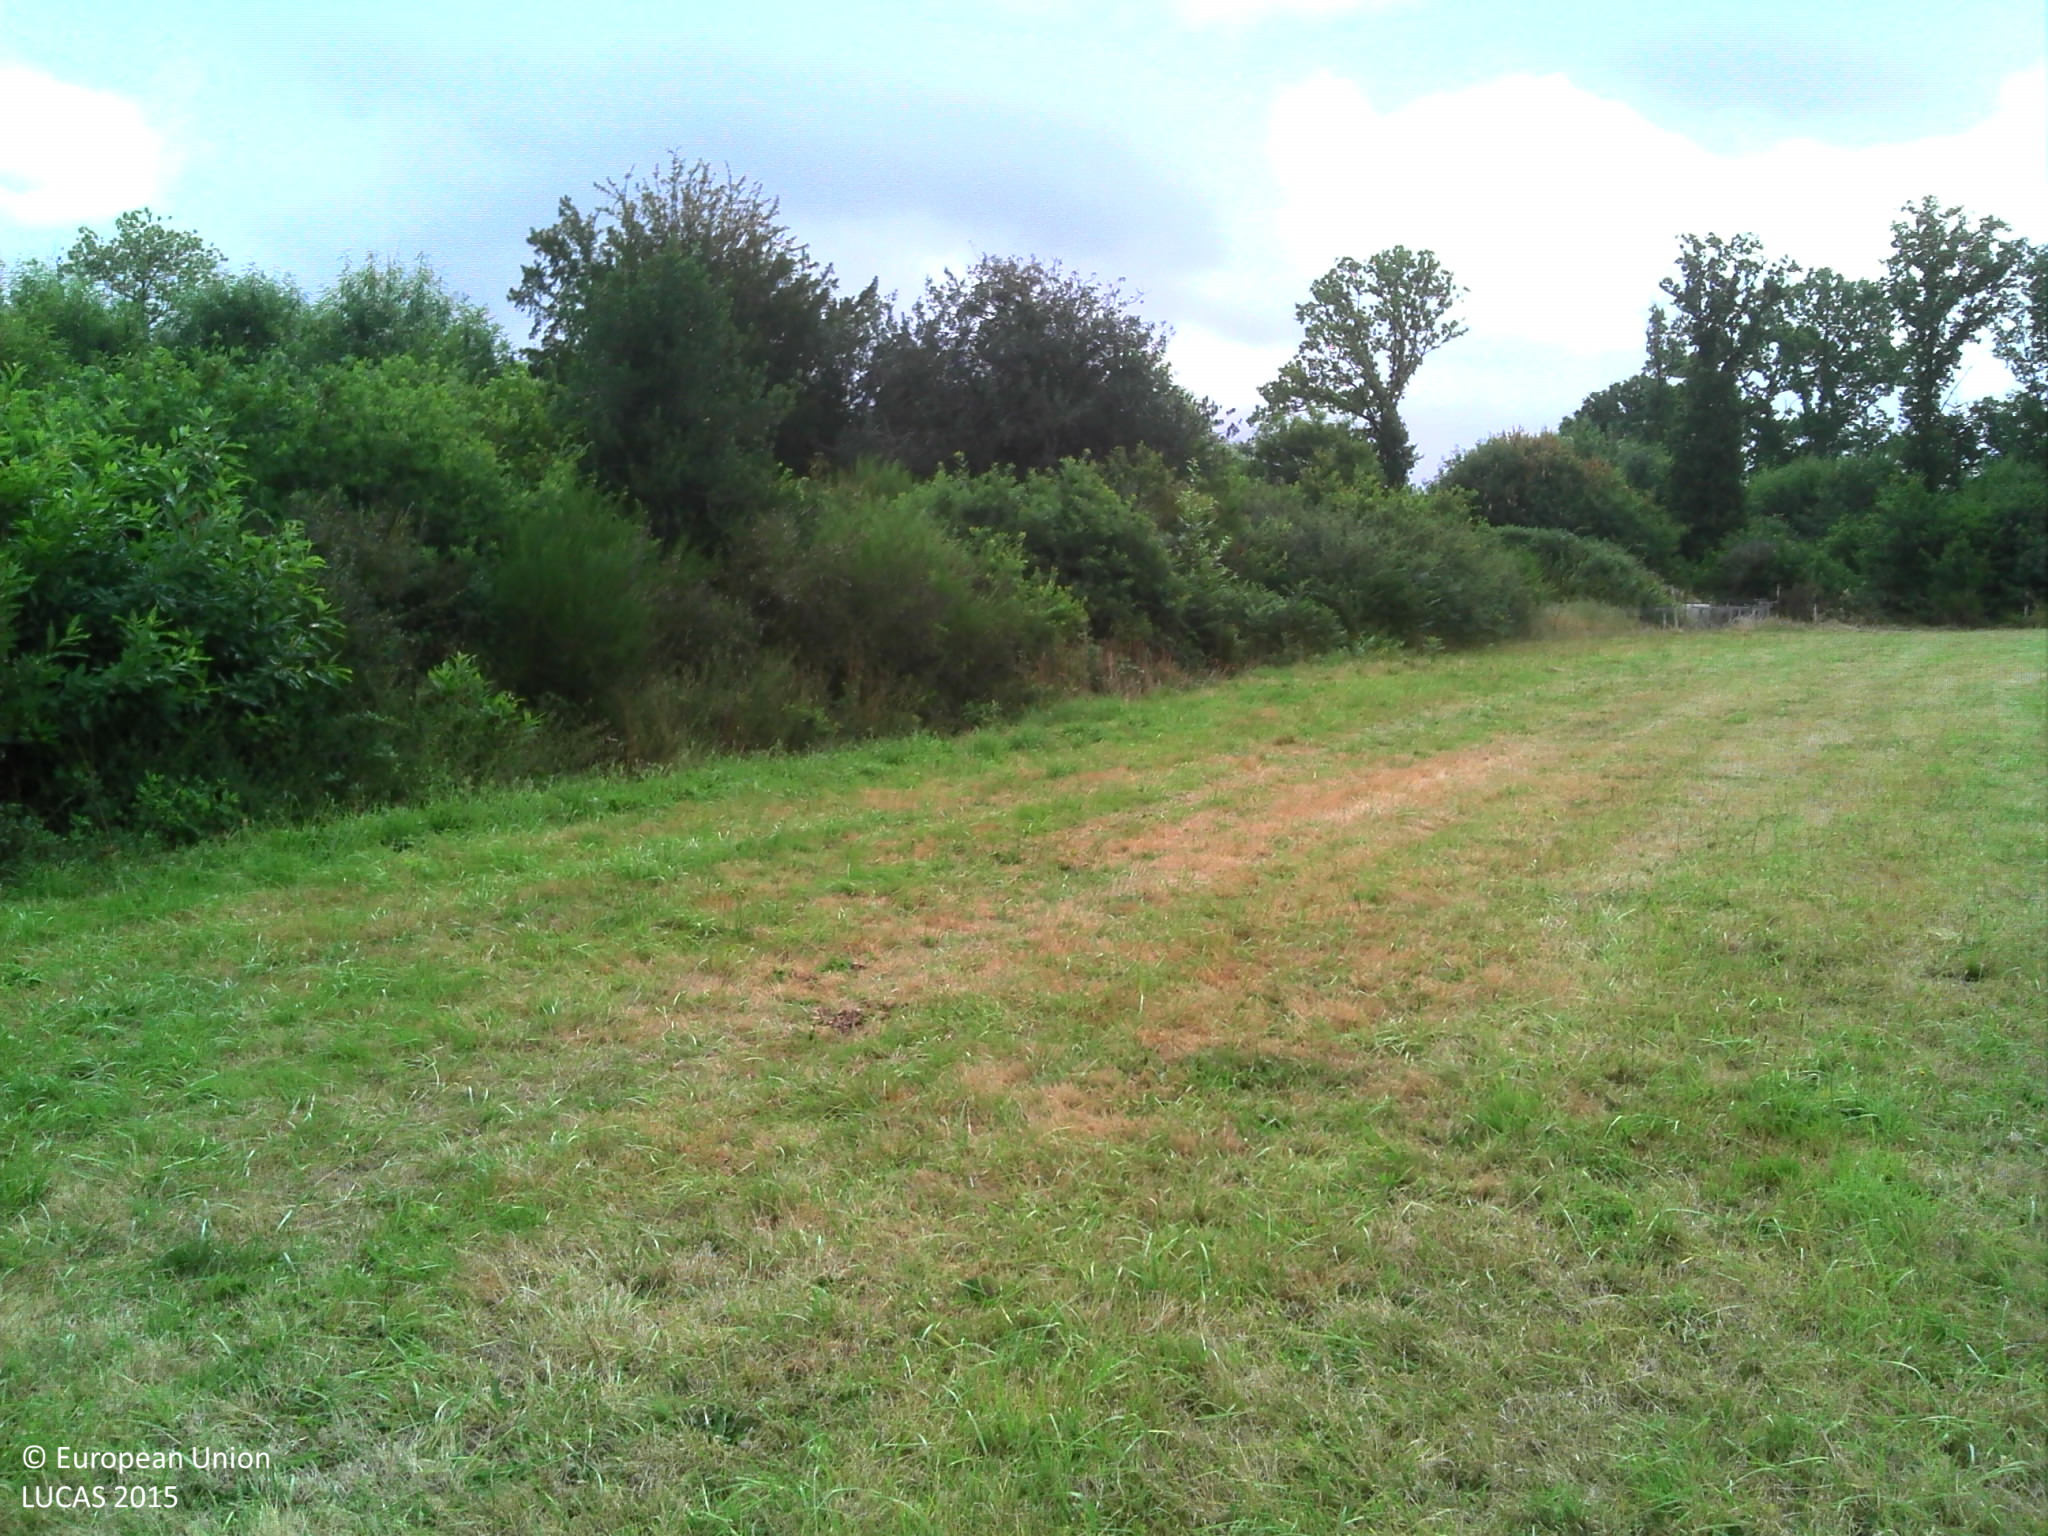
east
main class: Grassland
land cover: Grassland without tree/shrub cover
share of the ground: > 75 %
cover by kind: herbaceous plants 100 %
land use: Agriculture (excluding fallow land and kitchen gardens)
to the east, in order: Grassland without tree/shrub cover; Fences; Broadleaved woodland; Fences; Grassland without tree/shrub cover; Fences; Shrubland with sparse tree cover; Managed hedges; Ditches and canals; Grass margins; Paved roads, cycling and walking lanes; Grass margins; Ditches and canals; Broadleaved woodland
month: July
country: FR
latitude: 47.5654
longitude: -1.9991
